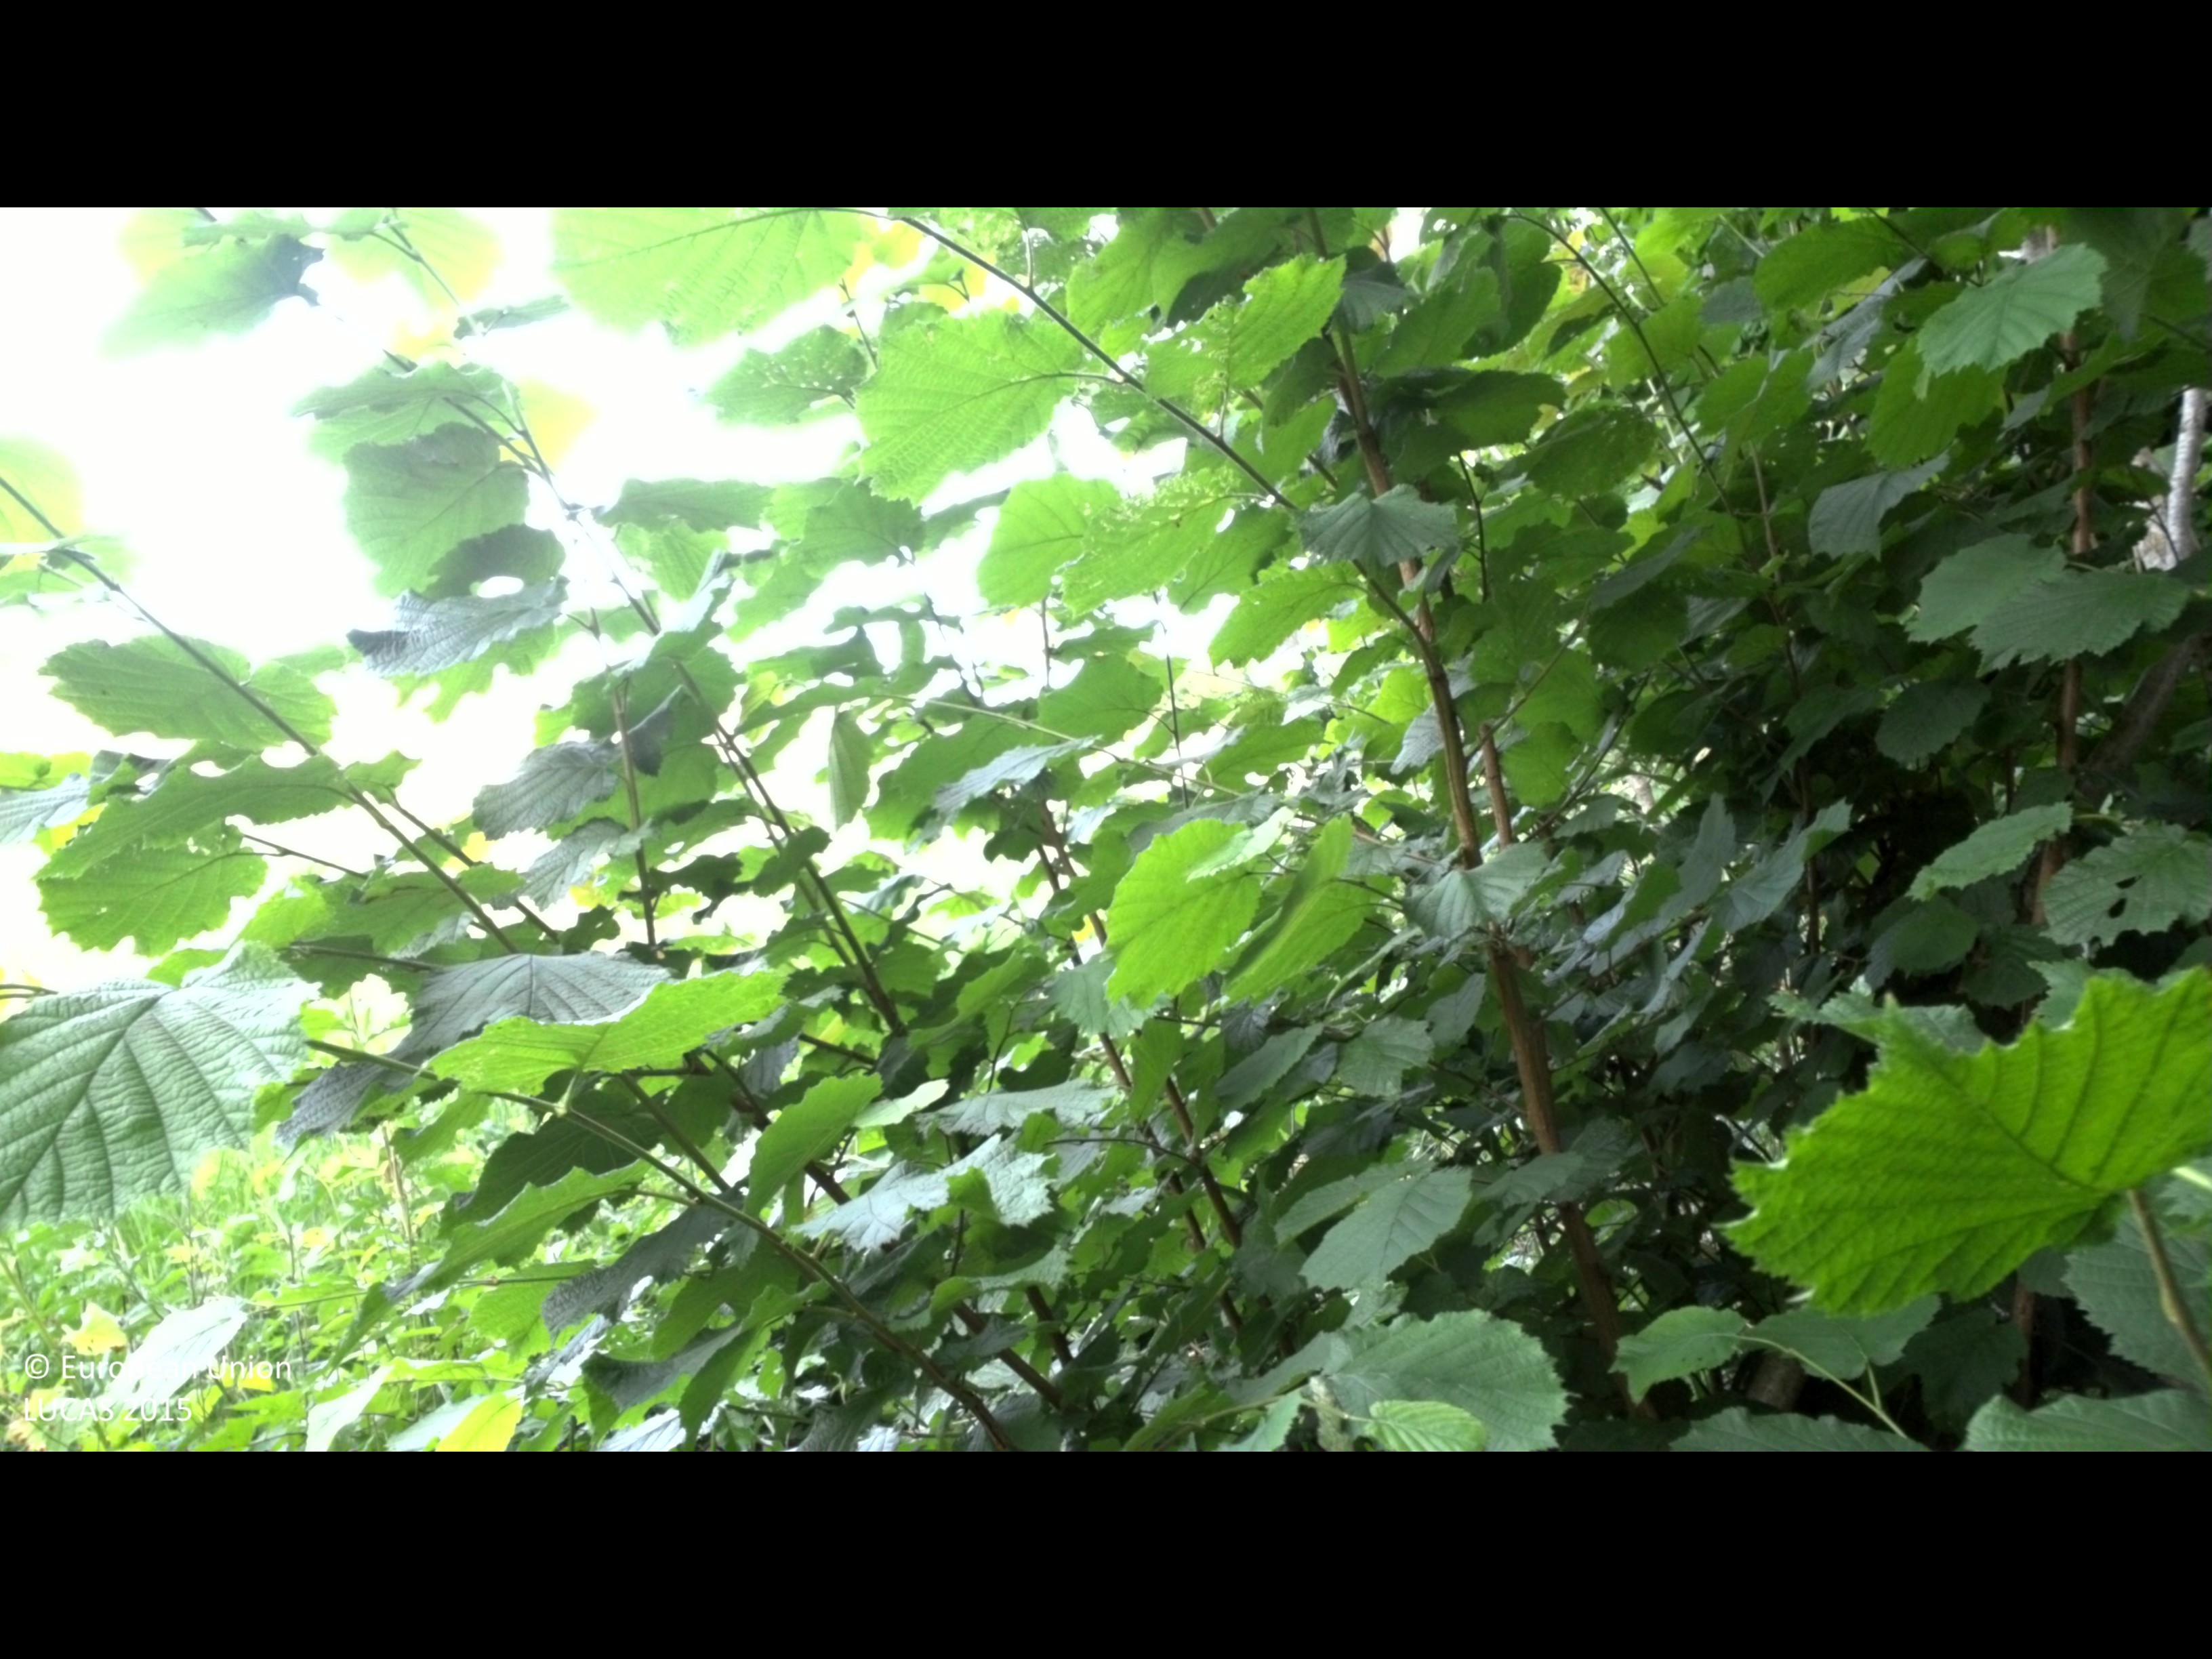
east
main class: Woodland
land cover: Broadleaved woodland
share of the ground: 25 - 50 %
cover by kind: broadleaved forest trees 50 %, shrubs 40 %, herbaceous plants 10 %
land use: Semi-natural and natural areas not in use
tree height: < 5 m
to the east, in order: Broadleaved woodland; Dry stone walls; Grassland without tree/shrub cover; Artificial constructions in urban areas; Grassland without tree/shrub cover; Shruby margins; Dry stone walls; Tracks; Shruby margins; Dry stone walls; Temporary grasslands
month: July
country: SE
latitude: 56.6653
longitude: 16.6427
